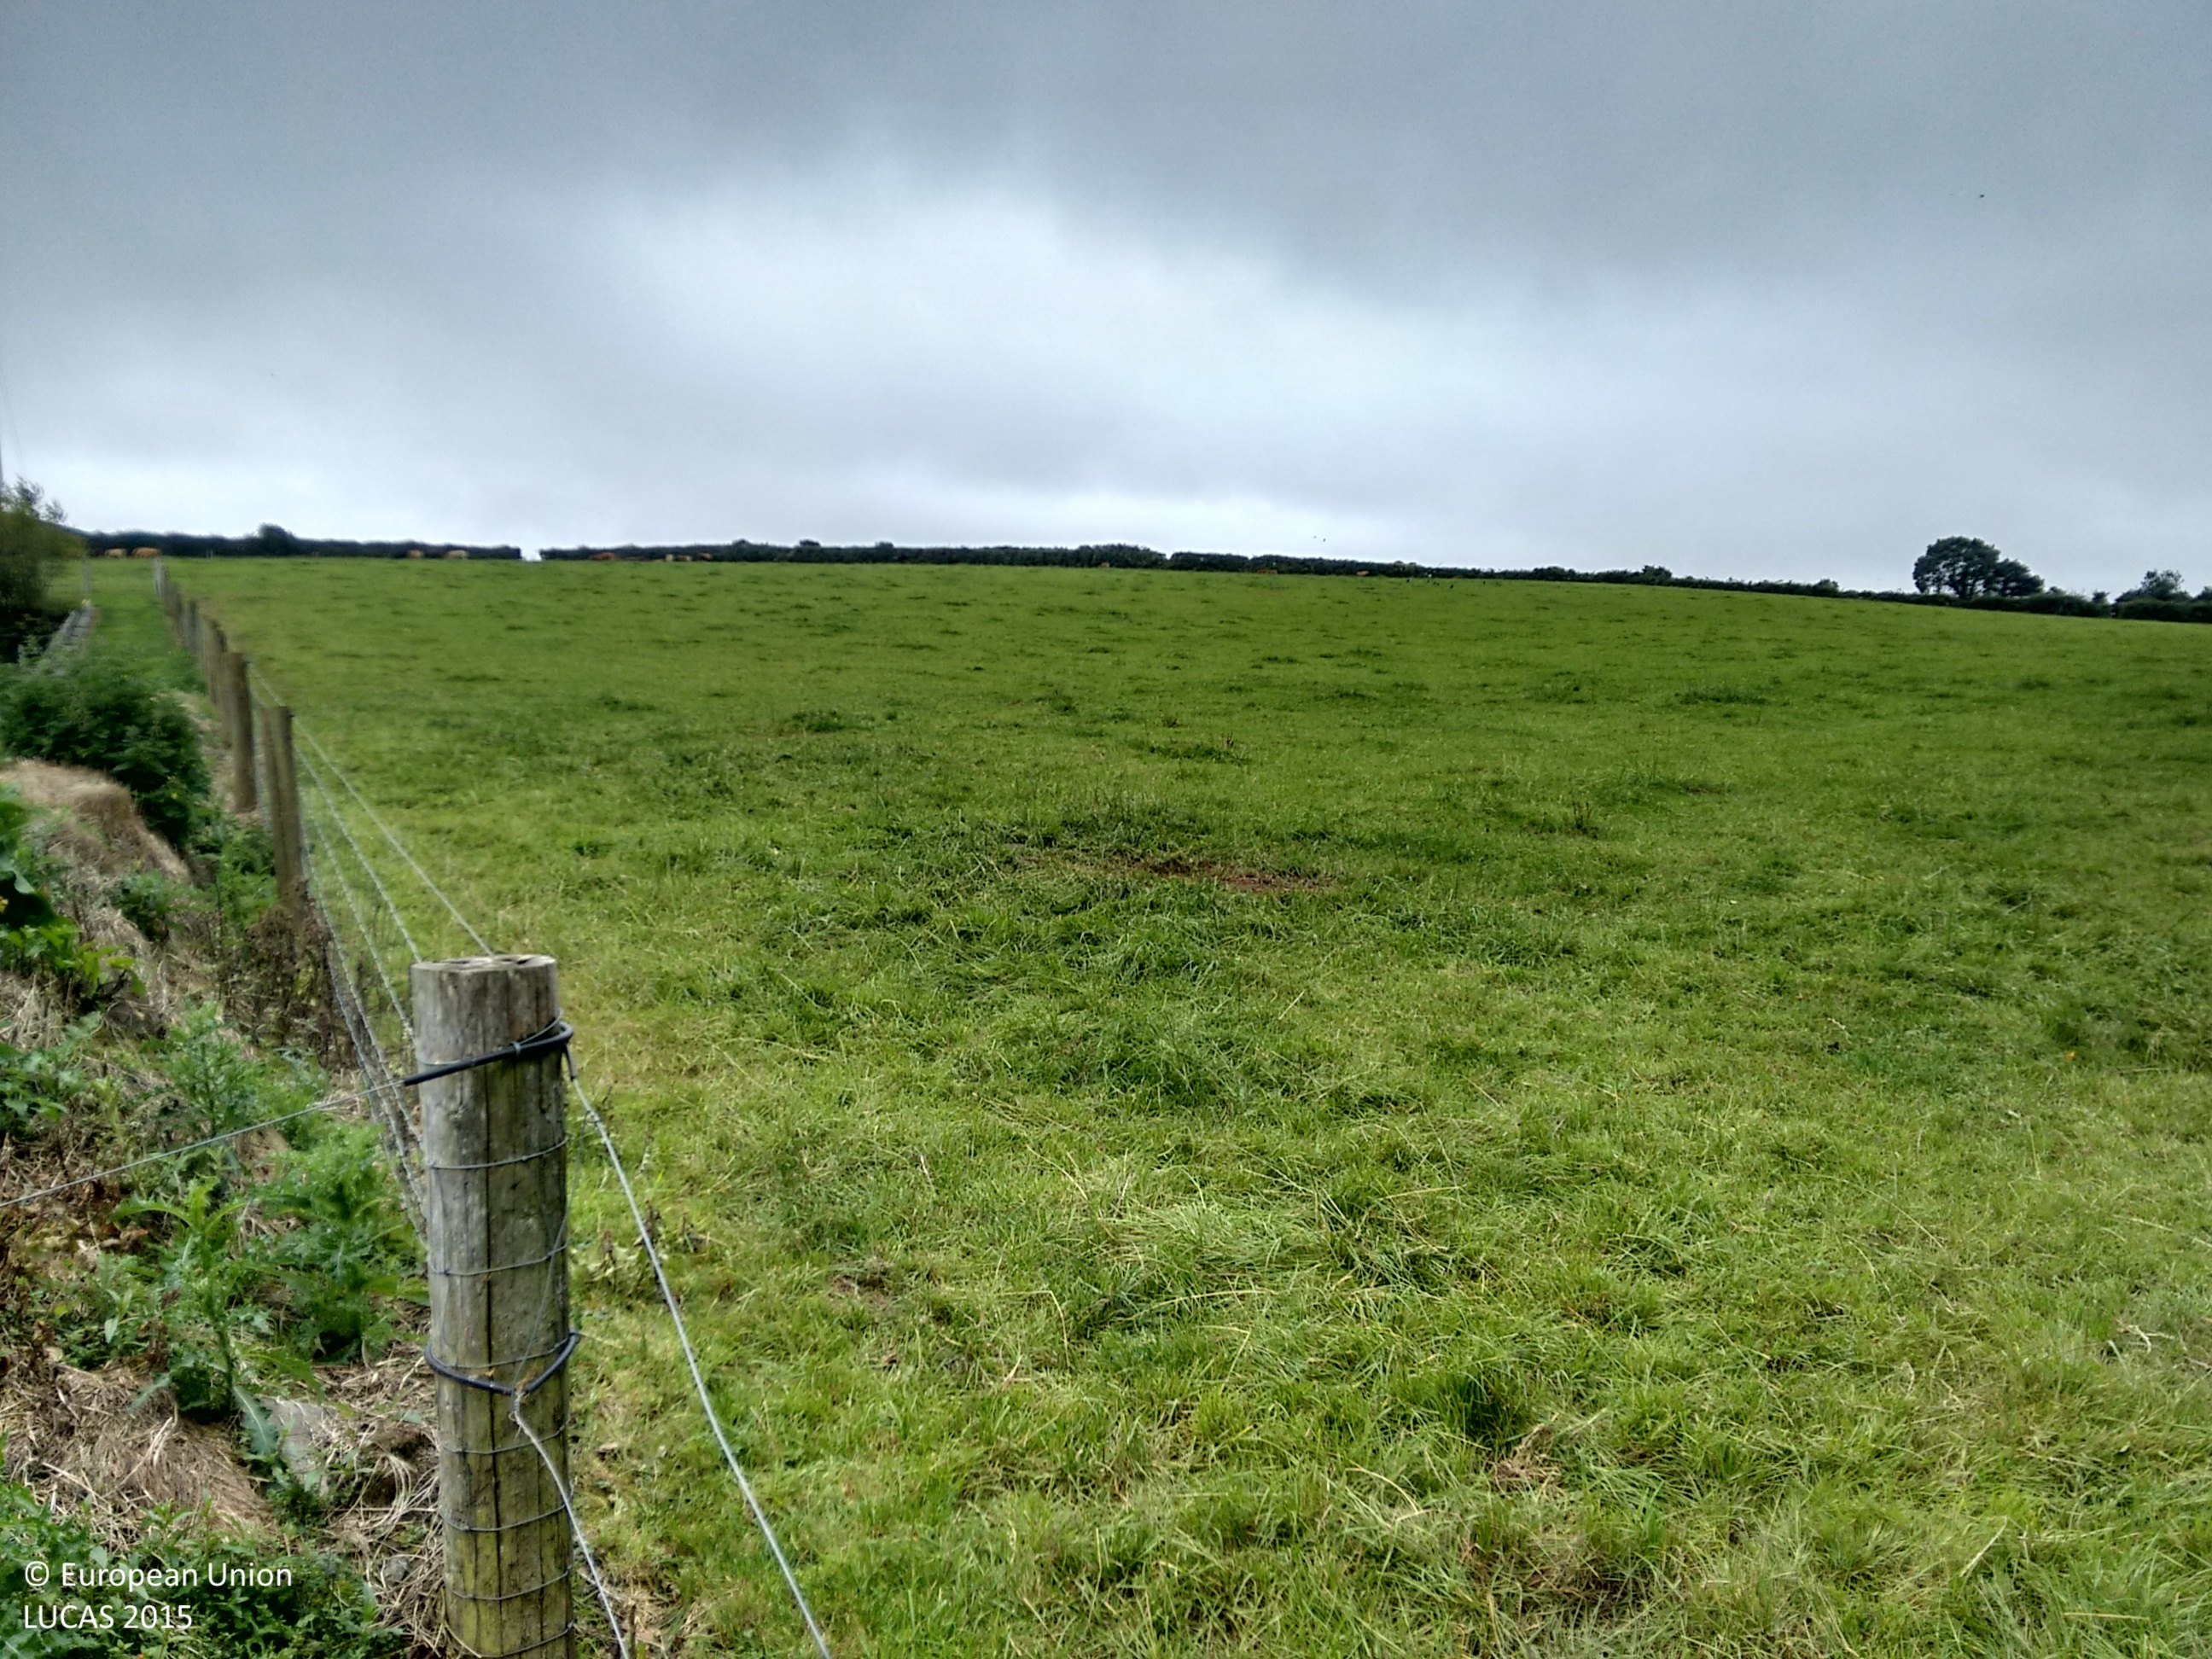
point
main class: Grassland
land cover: Grassland without tree/shrub cover
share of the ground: > 75 %
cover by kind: herbaceous plants 100 %
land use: Agriculture (excluding fallow land and kitchen gardens)
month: August
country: IE
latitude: 52.4472
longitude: -6.5946
